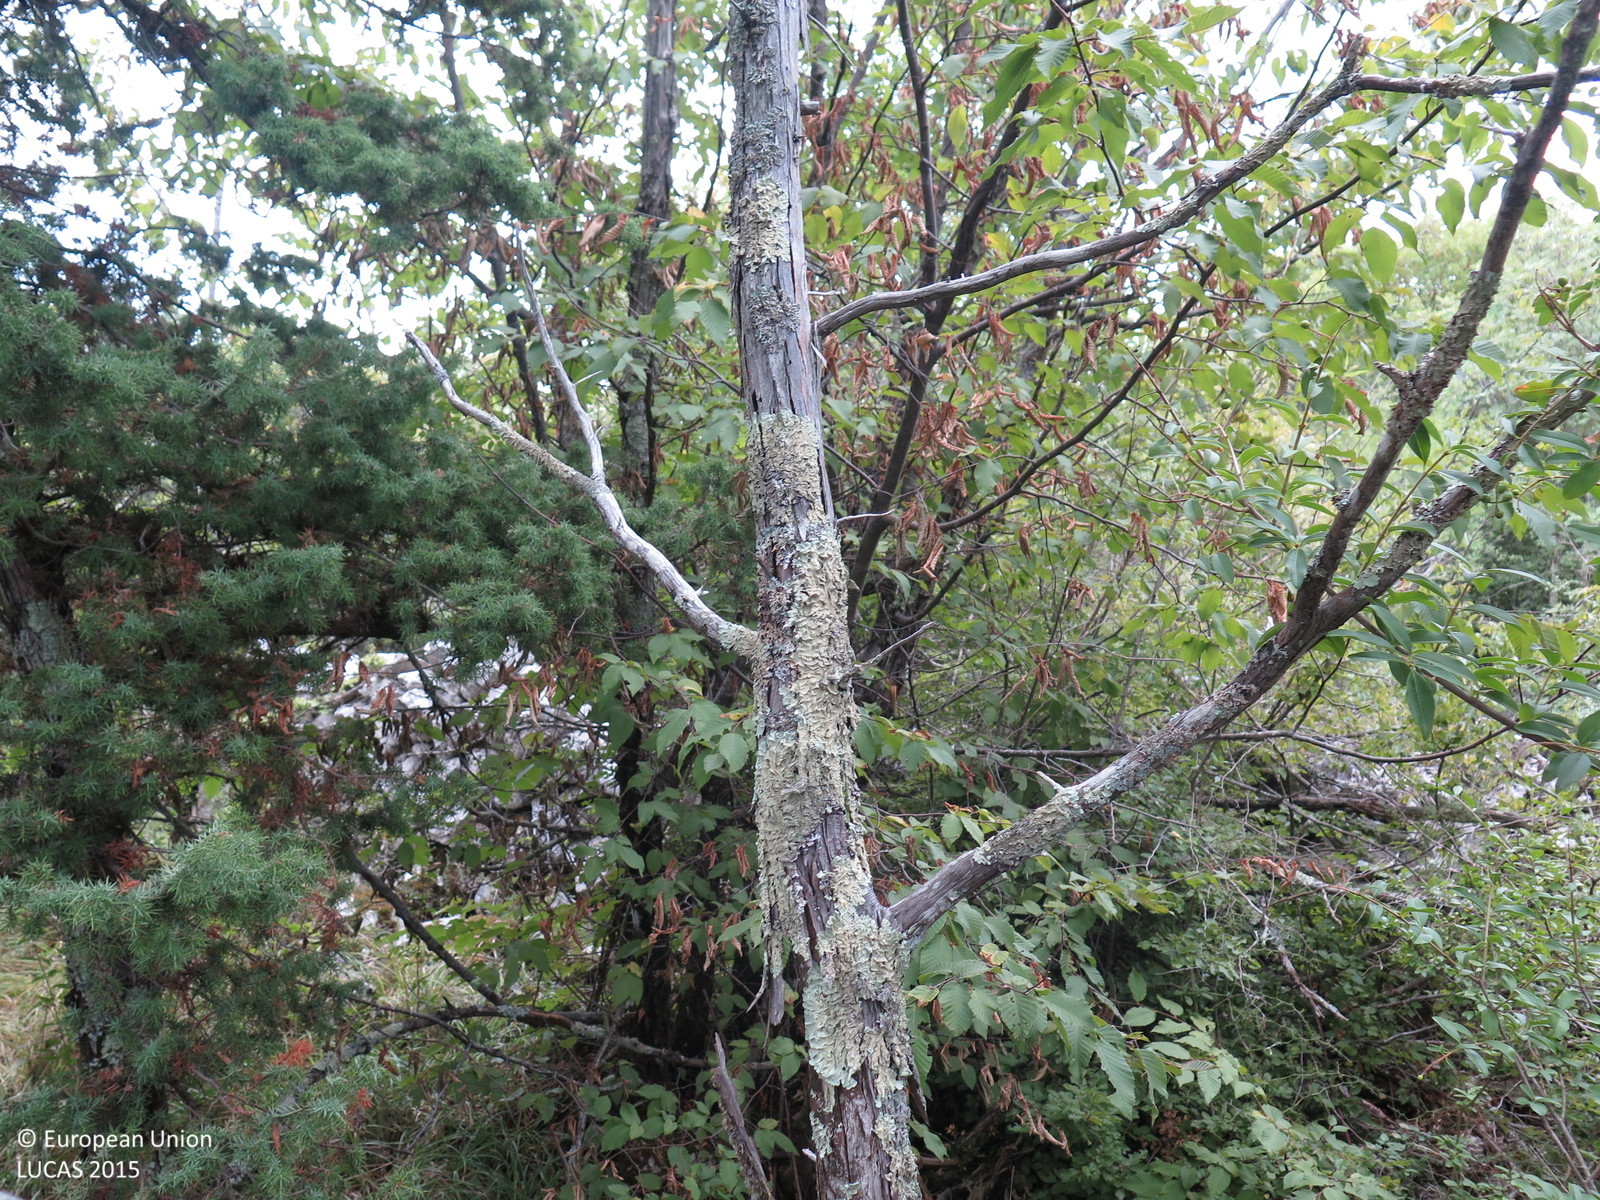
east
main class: Woodland
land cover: Broadleaved woodland
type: thermophilous deciduous forest
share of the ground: > 75 %
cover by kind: broadleaved forest trees 90 %, shrubs 5 %, herbaceous plants 5 %
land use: Semi-natural and natural areas not in use
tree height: > 5 m
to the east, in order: Broadleaved woodland; Dry stone walls; Broadleaved woodland
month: August
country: HR
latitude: 45.1330
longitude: 14.6102
